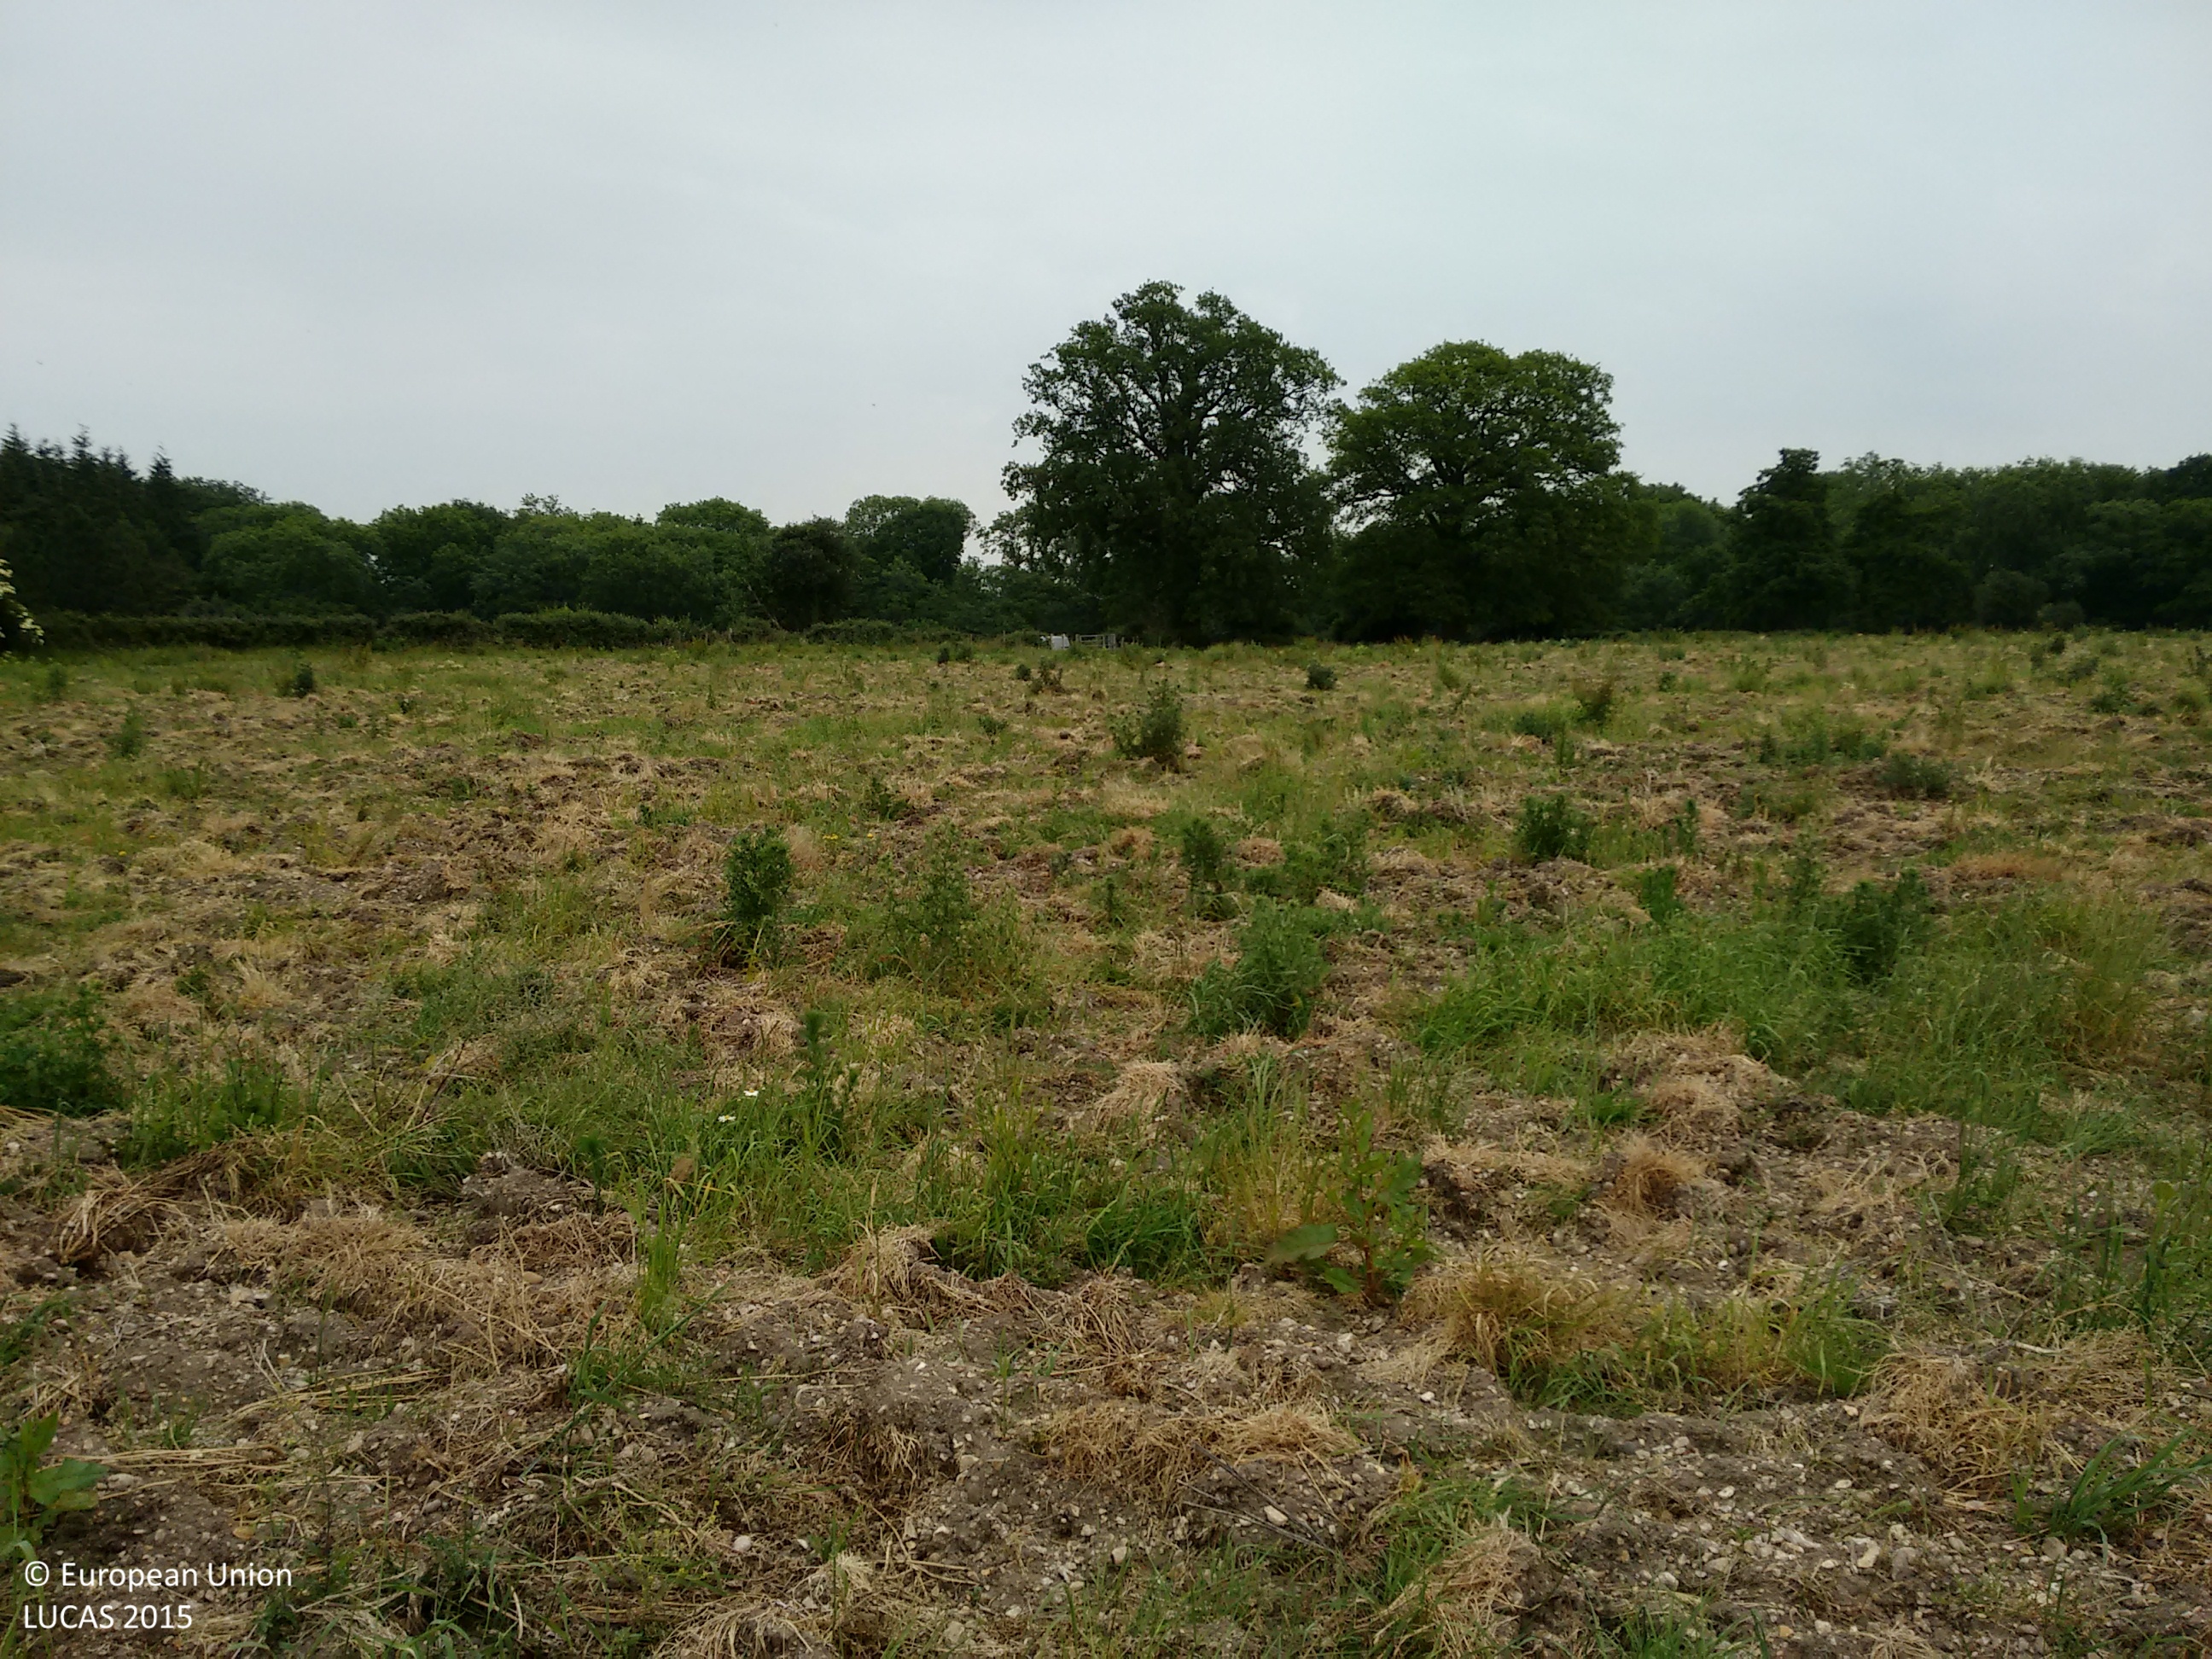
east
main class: Grassland
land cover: Grassland without tree/shrub cover
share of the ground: > 75 %
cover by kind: herbaceous plants 75 %, unconsolidated bare surface 25 %
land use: Agriculture (excluding fallow land and kitchen gardens)
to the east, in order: Grassland without tree/shrub cover; Managed hedges; Grass margins; Paved roads, cycling and walking lanes; Grass margins; Managed hedges; Grassland without tree/shrub cover; Fences; Broadleaved woodland; Rivers and streams; Broadleaved woodland
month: June
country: GB
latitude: 51.4013
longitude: -1.0997
